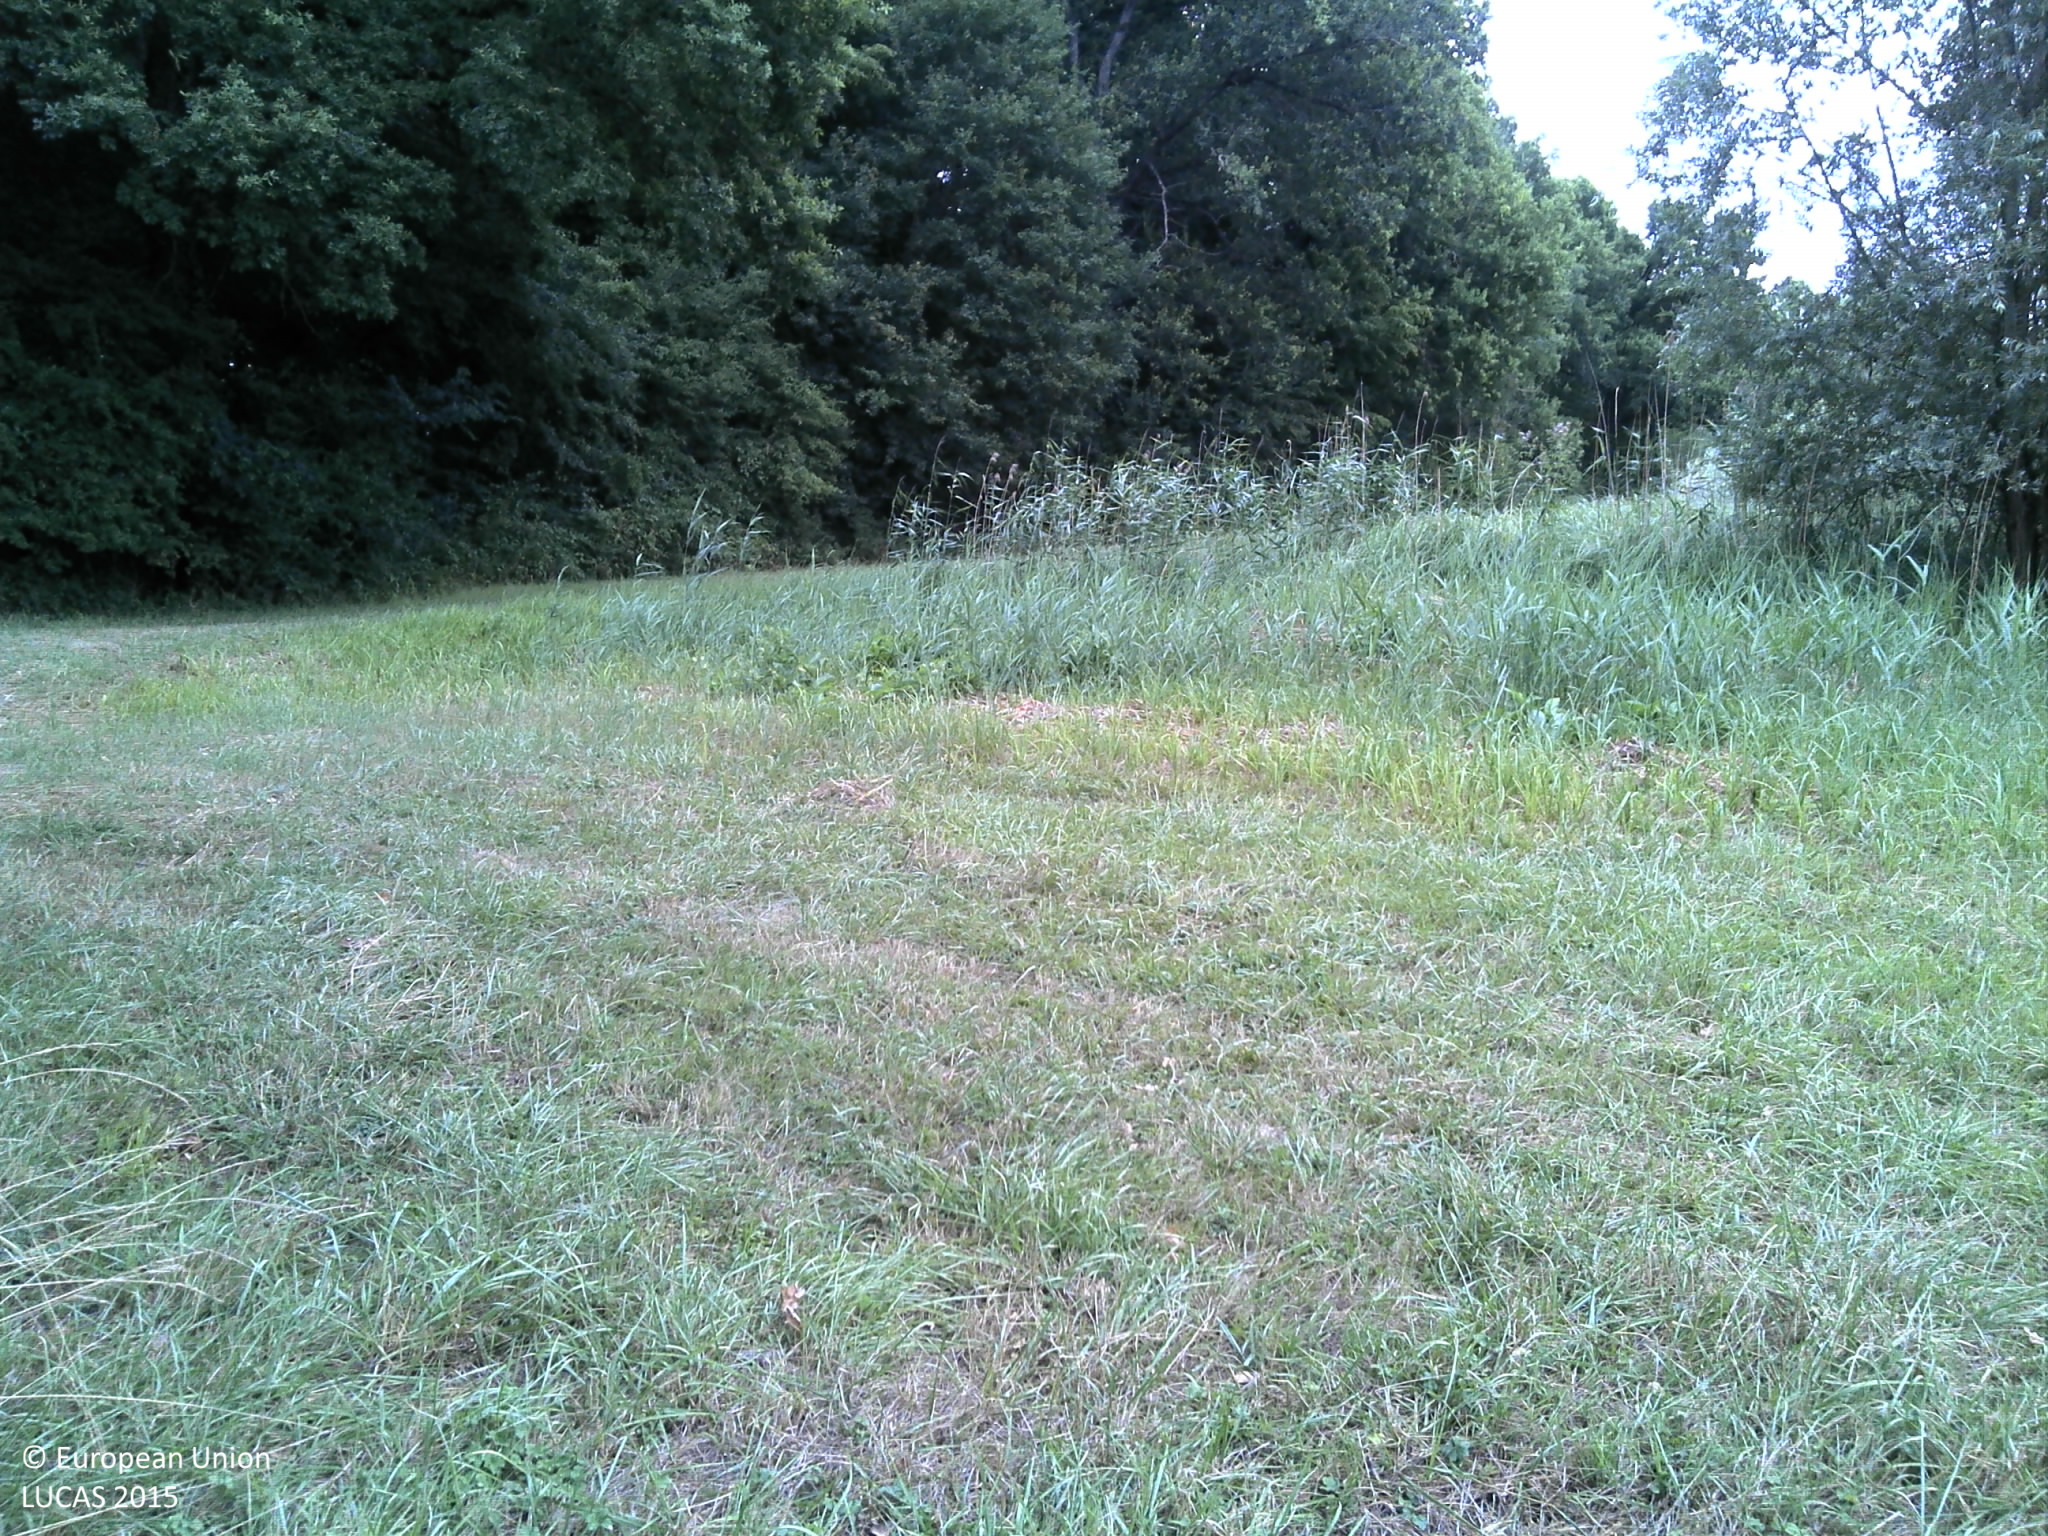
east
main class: Grassland
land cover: Grassland with sparse tree/shrub cover
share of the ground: > 75 %
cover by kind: herbaceous plants 95 %, broadleaved forest trees 5 %
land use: Agriculture (excluding fallow land and kitchen gardens)
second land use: Amenities, museums, leisure
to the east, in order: Grassland with sparse tree/shrub cover; Spontaneously vegetated surfaces; Inland fresh water bodies; Tracks; Broadleaved woodland; Ditches and canals; Grassland without tree/shrub cover; Broadleaved woodland
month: July
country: FR
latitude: 48.5776
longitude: 4.5891
